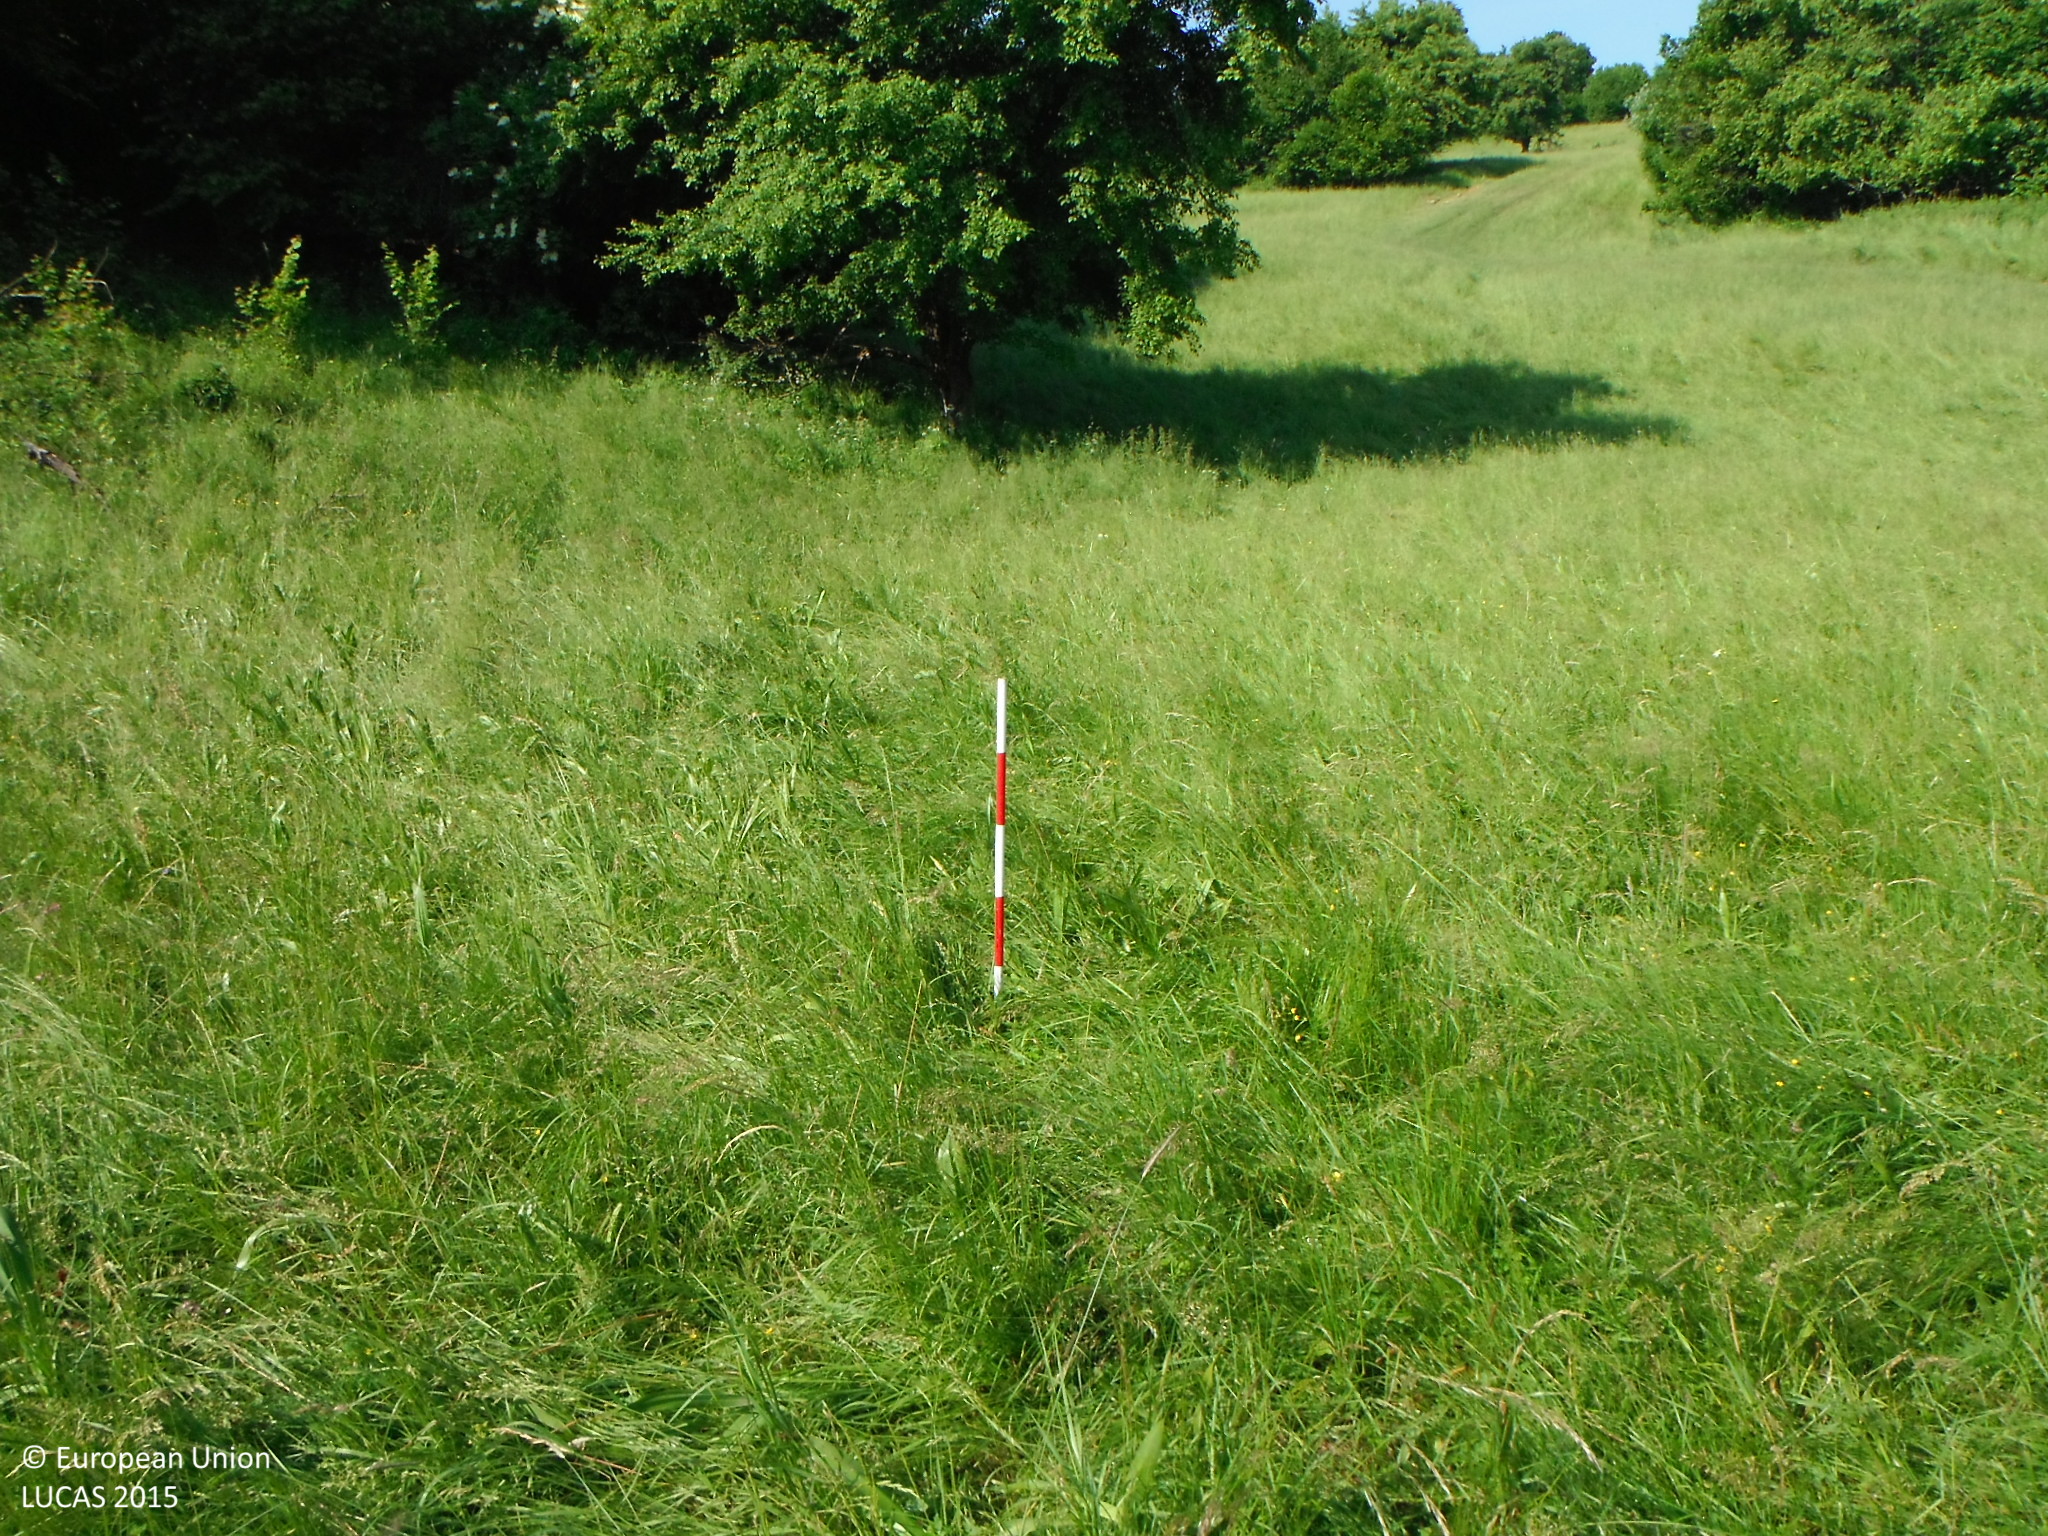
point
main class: Grassland
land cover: Grassland without tree/shrub cover
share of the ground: > 75 %
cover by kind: herbaceous plants 100 %
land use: Agriculture (excluding fallow land and kitchen gardens)
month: June
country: SK
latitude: 48.7499
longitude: 19.3405
